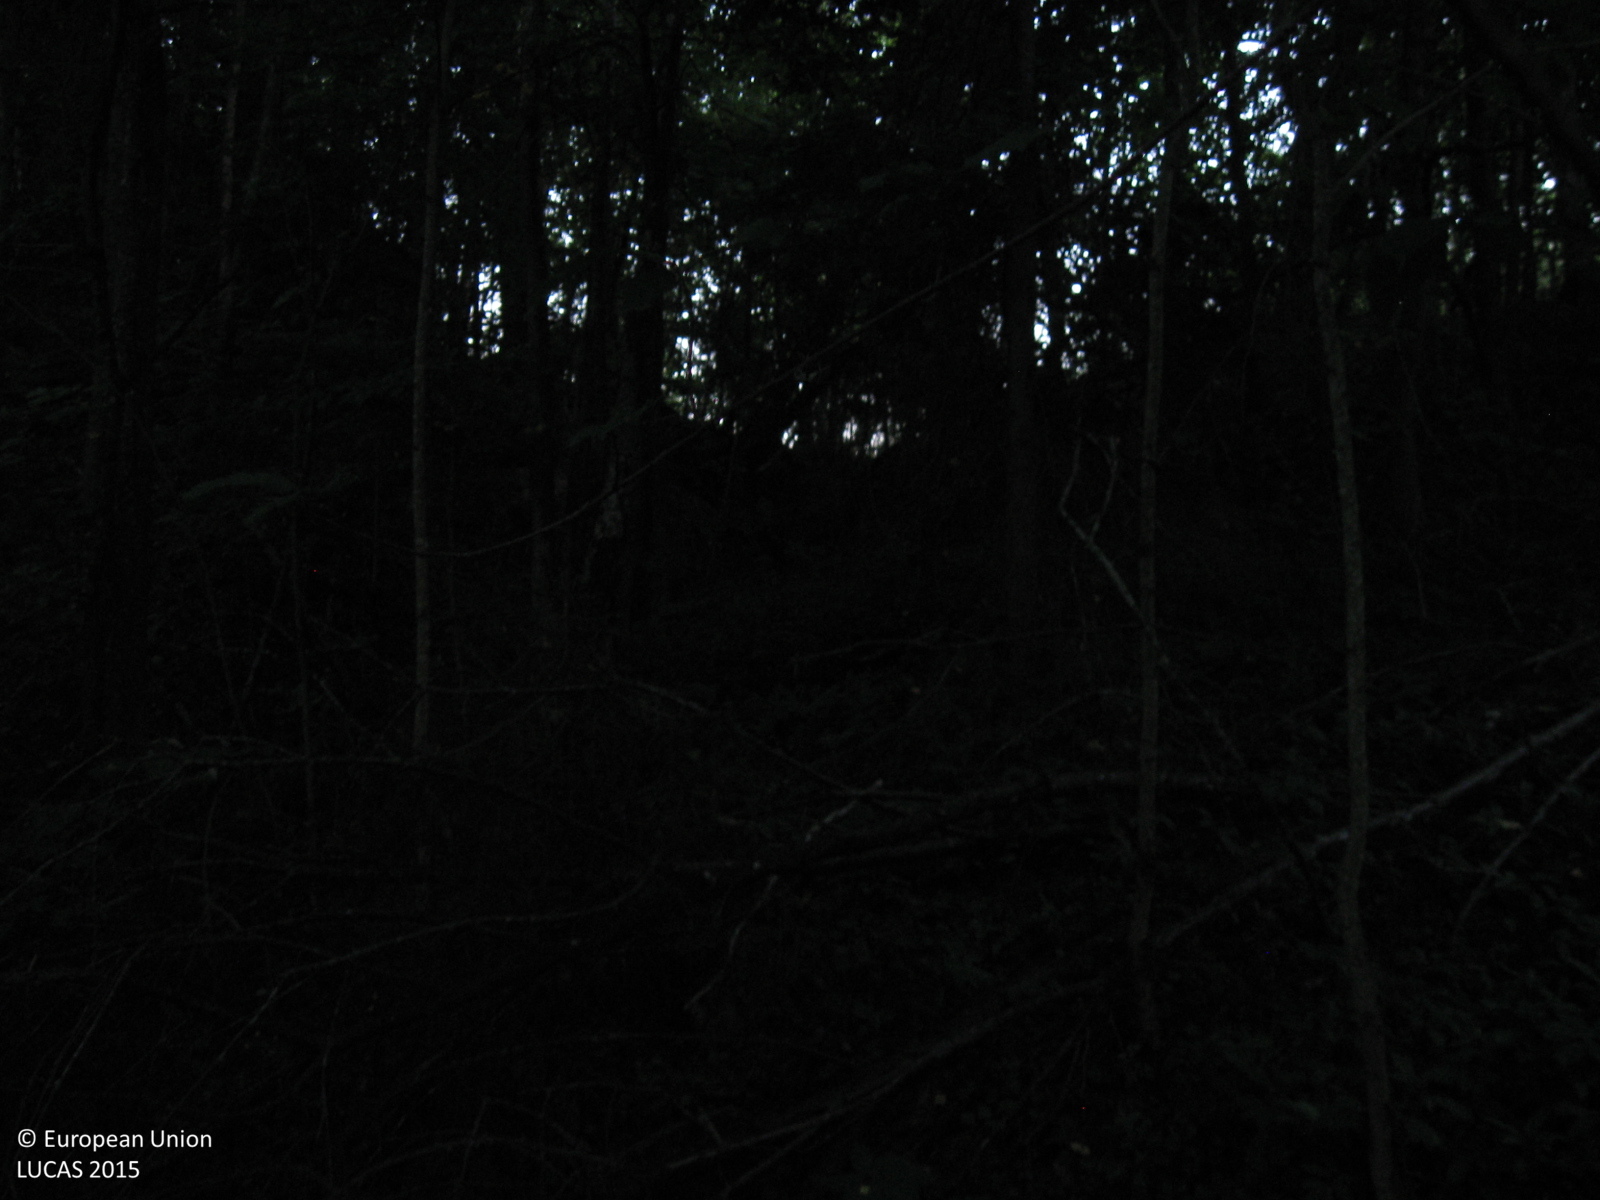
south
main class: Woodland
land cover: Broadleaved woodland
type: floodplain forest
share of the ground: > 75 %
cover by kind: broadleaved forest trees 90 %, coniferous forest trees 5 %, herbaceous plants 5 %
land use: Forestry
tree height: > 5 m
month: August
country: LT
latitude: 55.4988
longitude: 23.2288
